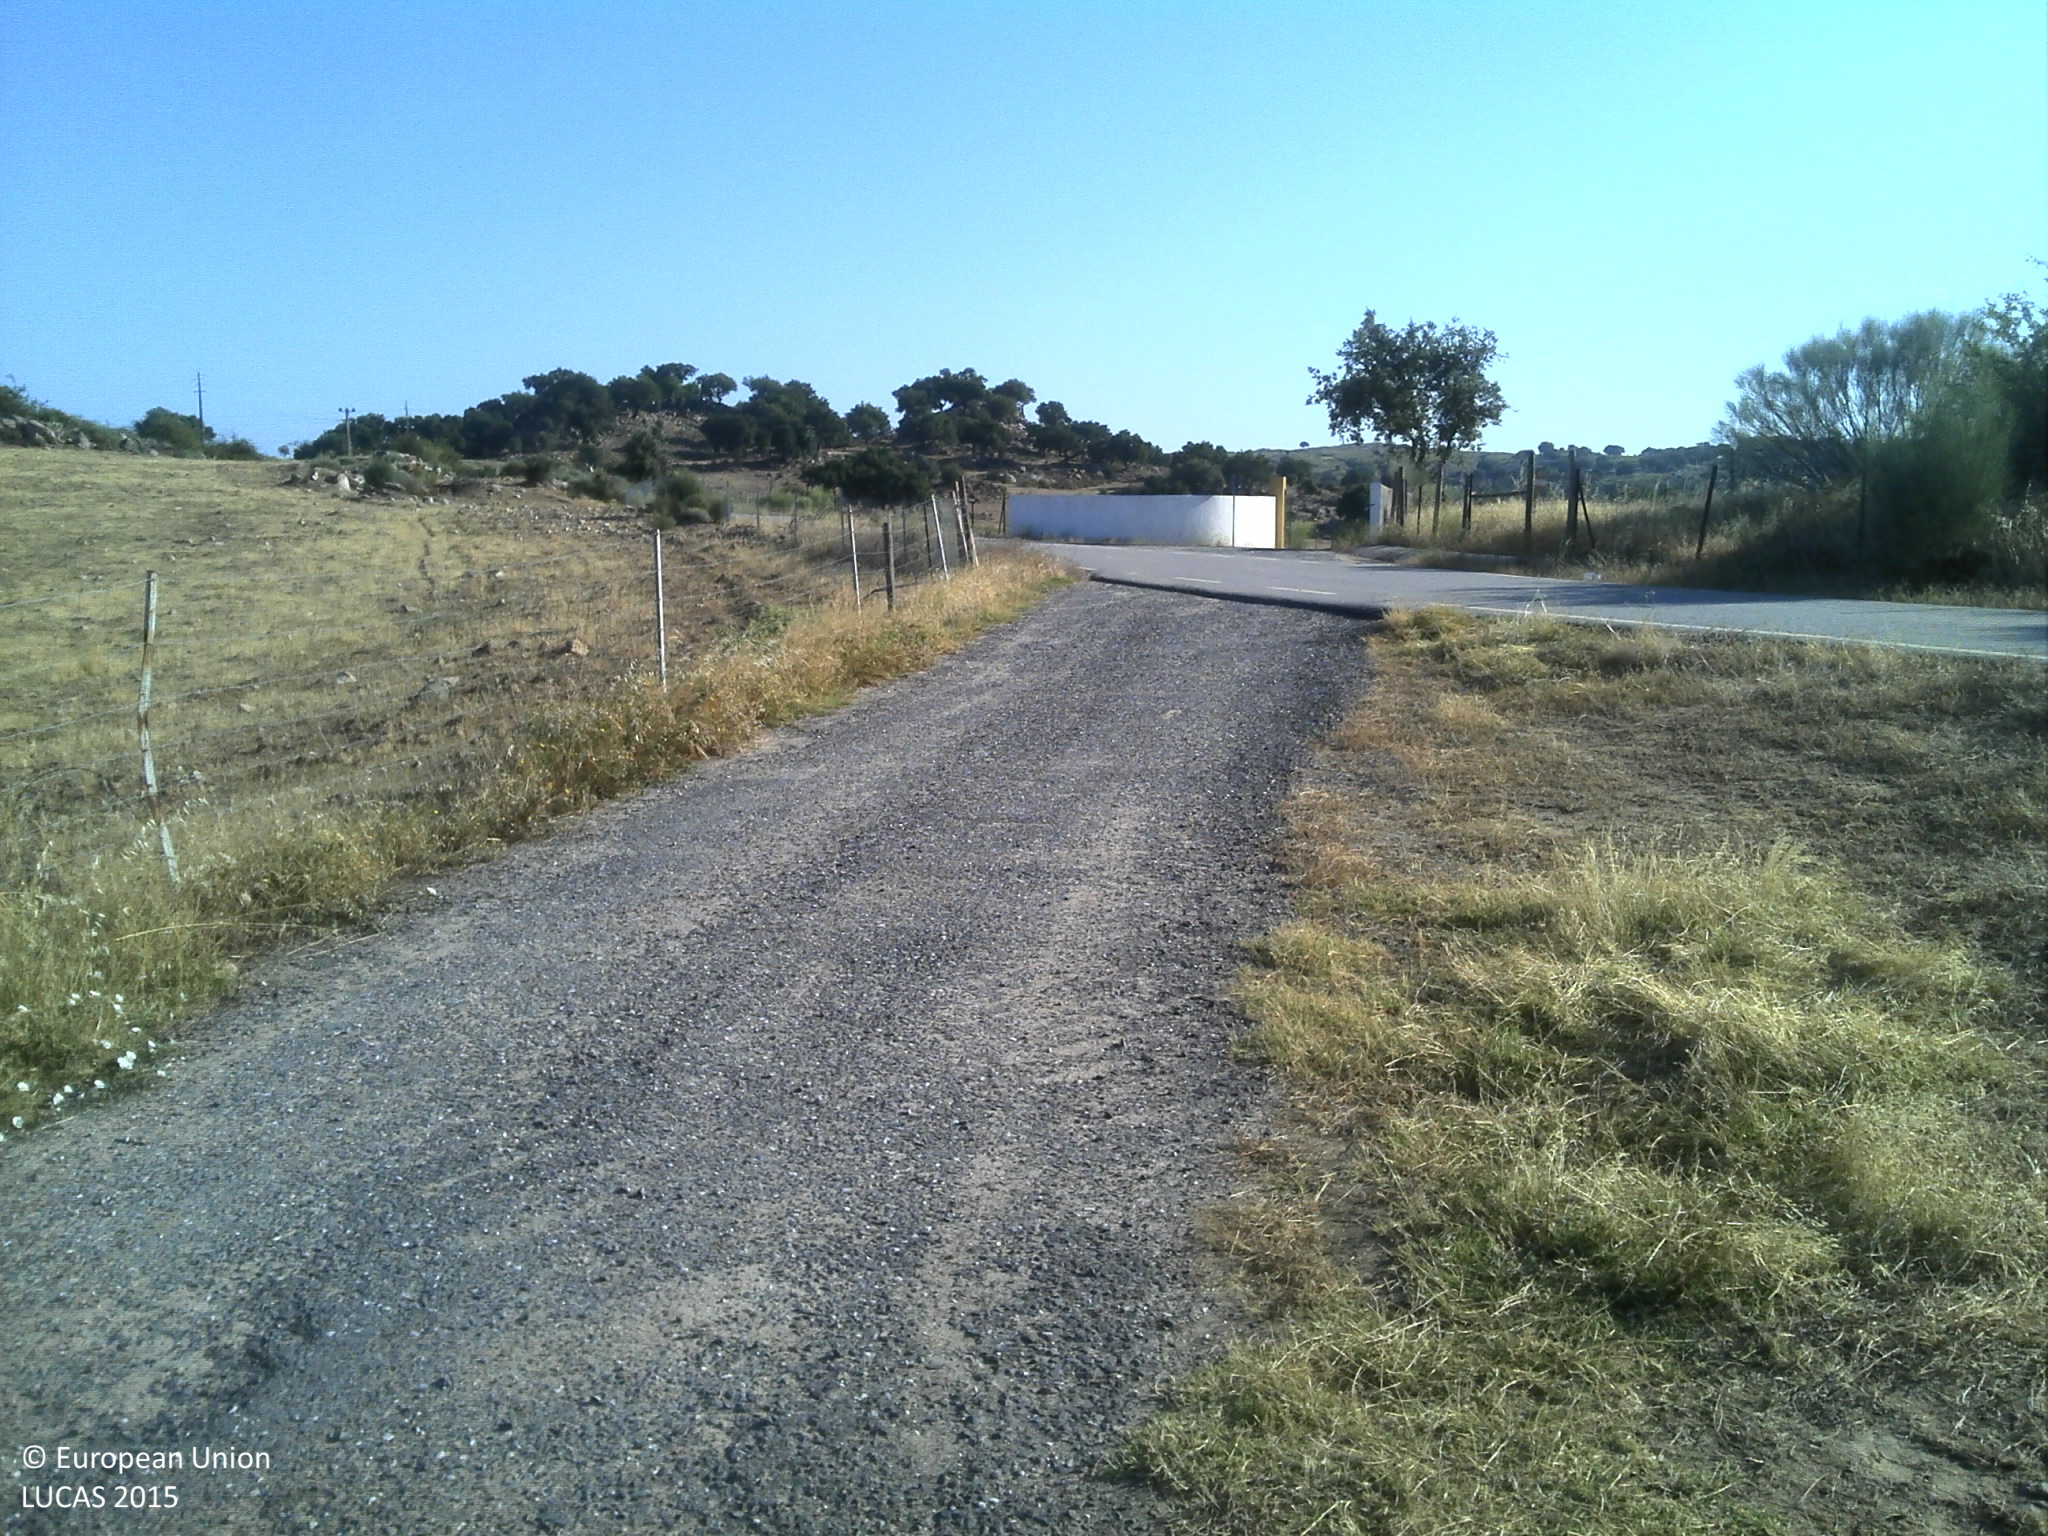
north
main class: Cropland
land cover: Arable land (only in case pi)
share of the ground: 50 - 75 %
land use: Agriculture (excluding fallow land and kitchen gardens)
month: June
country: PT
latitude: 39.9157
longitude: -7.3052
